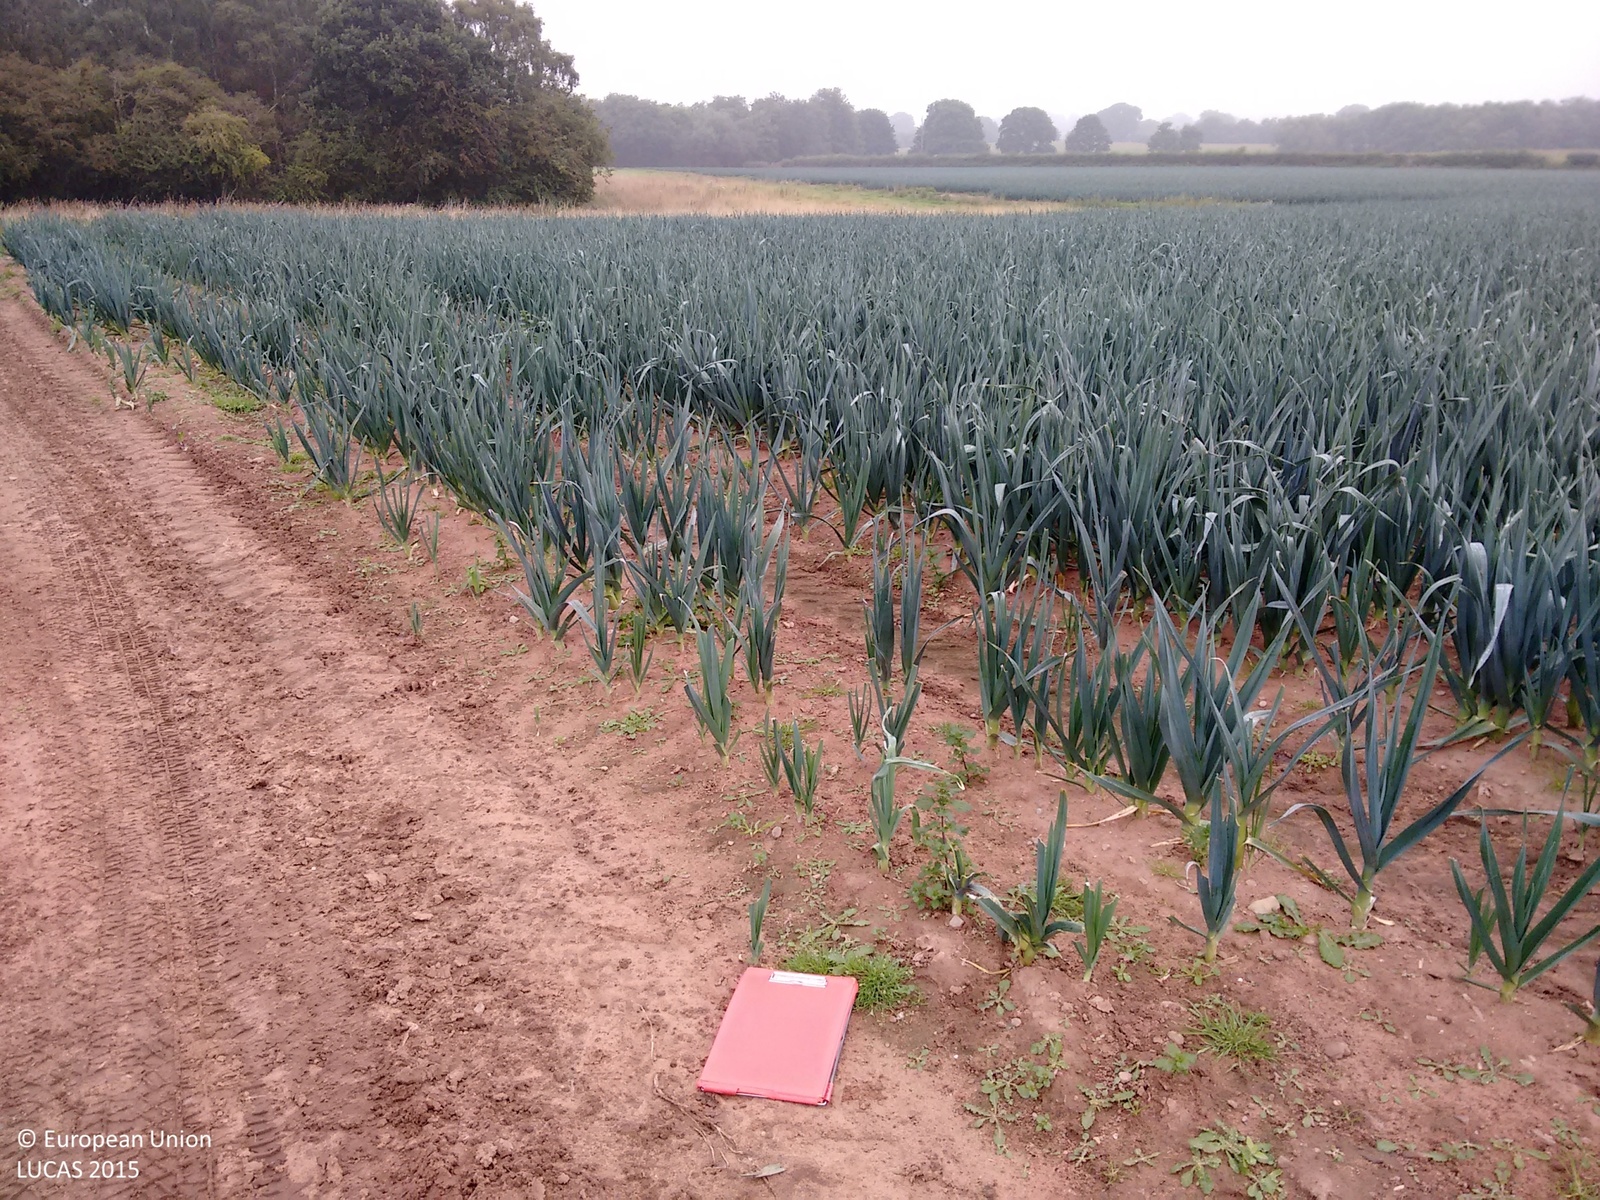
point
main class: Cropland
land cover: Other fresh vegetables
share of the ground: > 75 %
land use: Agriculture (excluding fallow land and kitchen gardens)
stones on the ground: 10 - 25 %
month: September
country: GB
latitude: 52.7782
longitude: -2.9265
